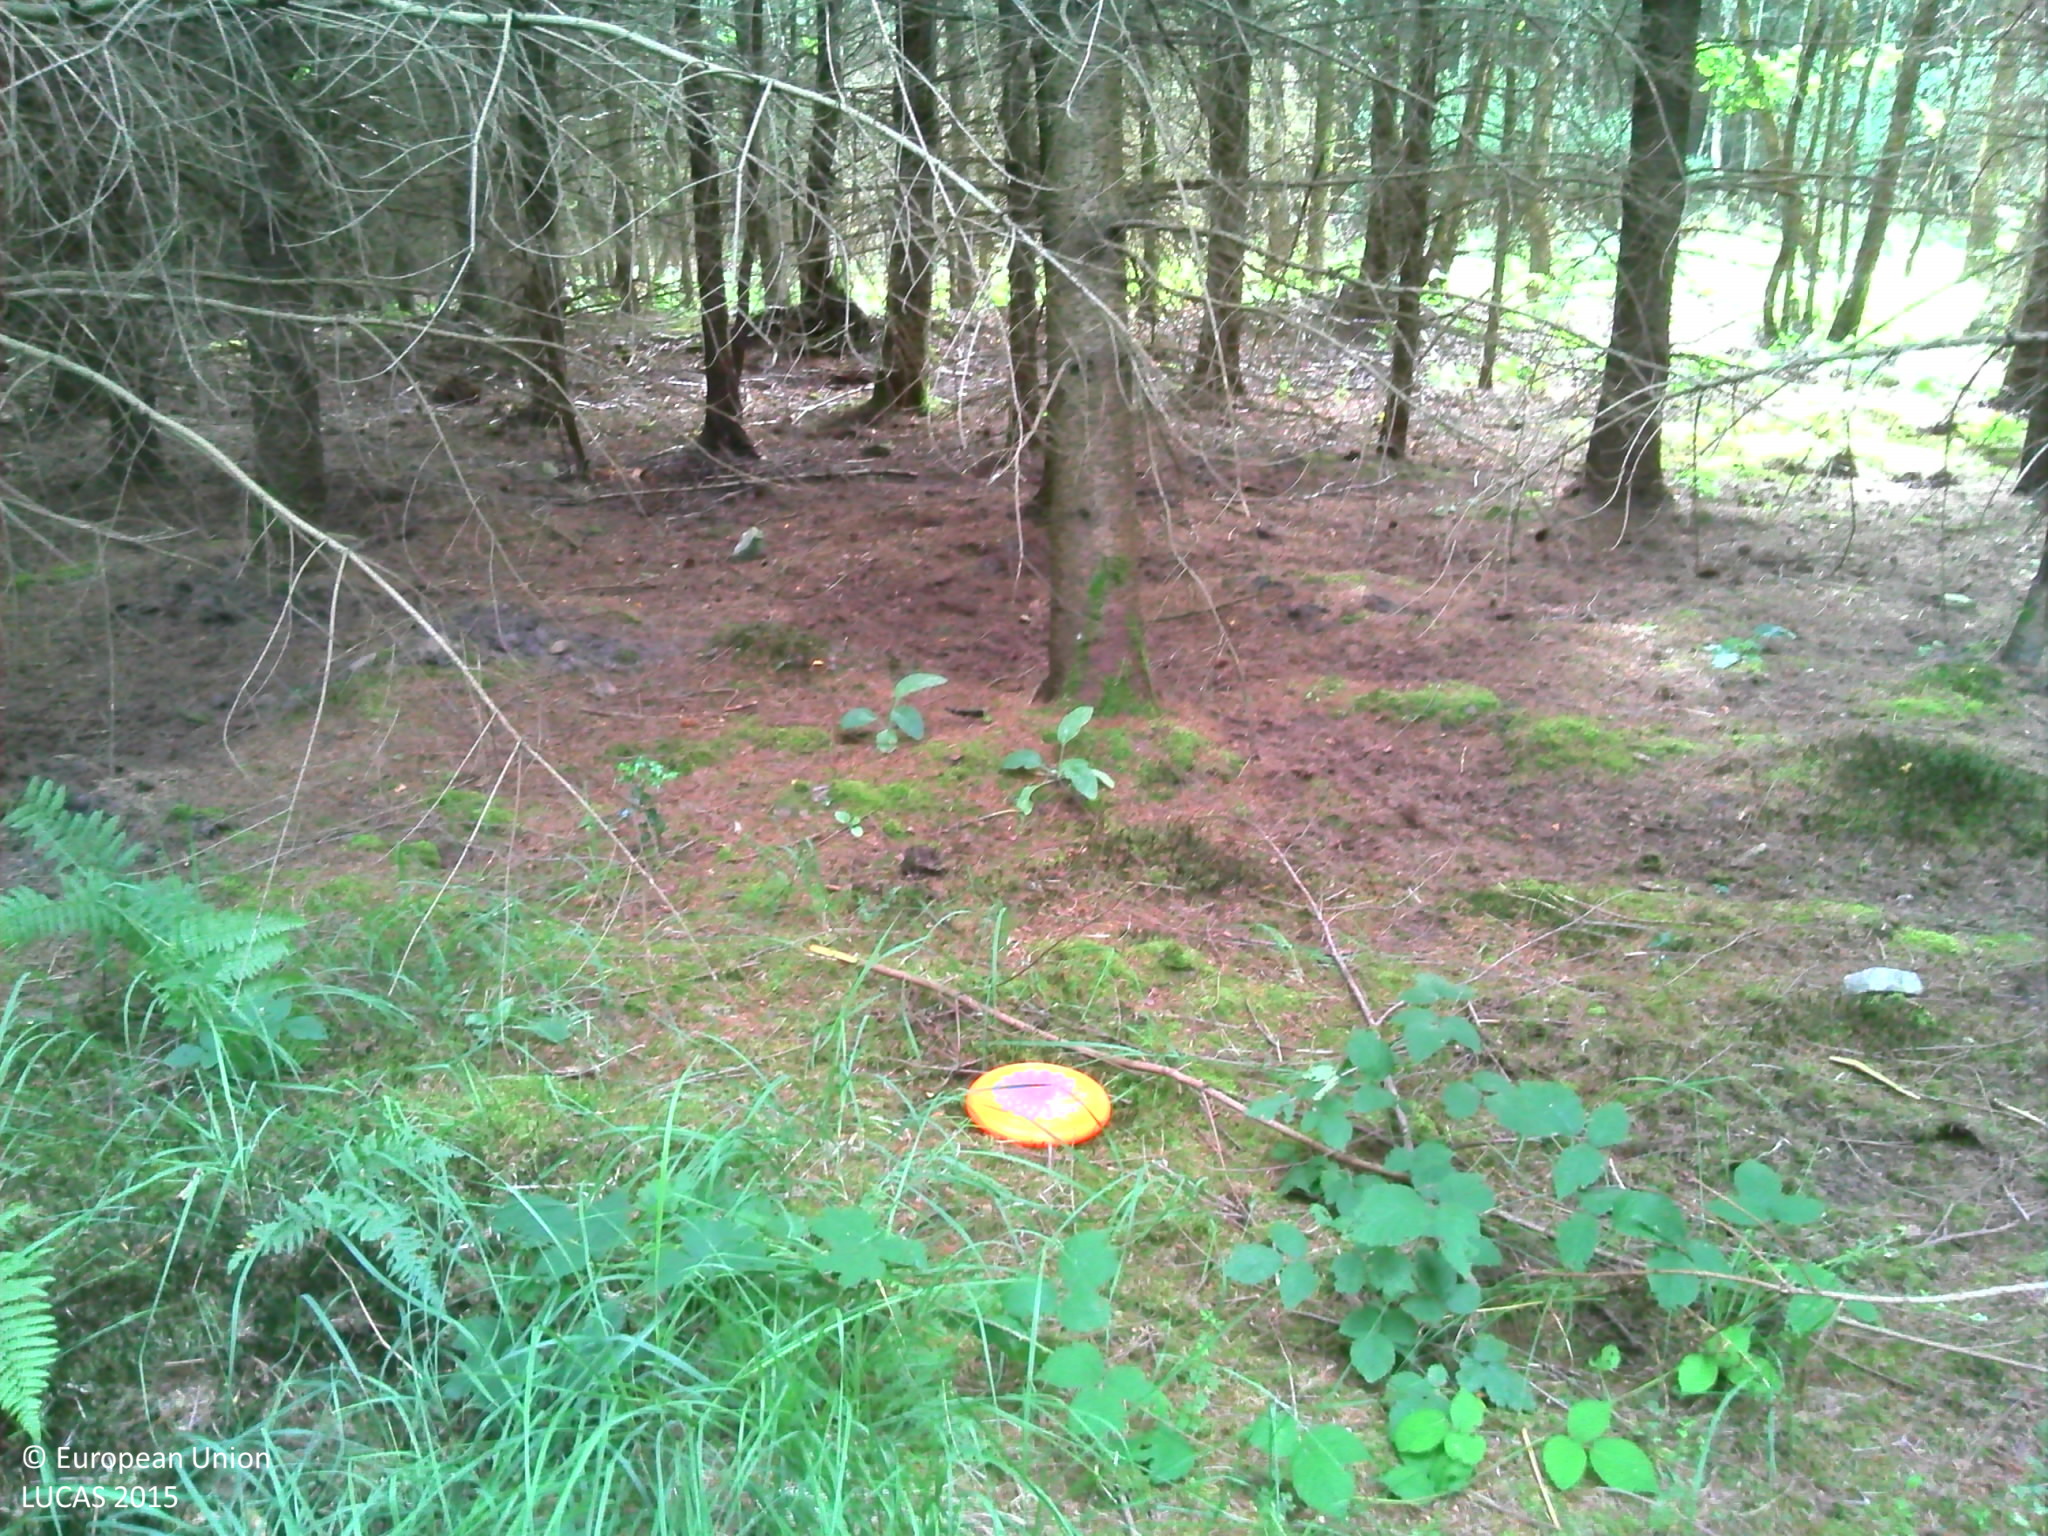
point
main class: Woodland
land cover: Spruce dominated coniferous woodland
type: mesophytic deciduous forest
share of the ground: > 75 %
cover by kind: coniferous forest trees 95 %, herbaceous plants 5 %
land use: Forestry
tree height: > 5 m
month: August
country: FR
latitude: 48.5111
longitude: -0.1976
